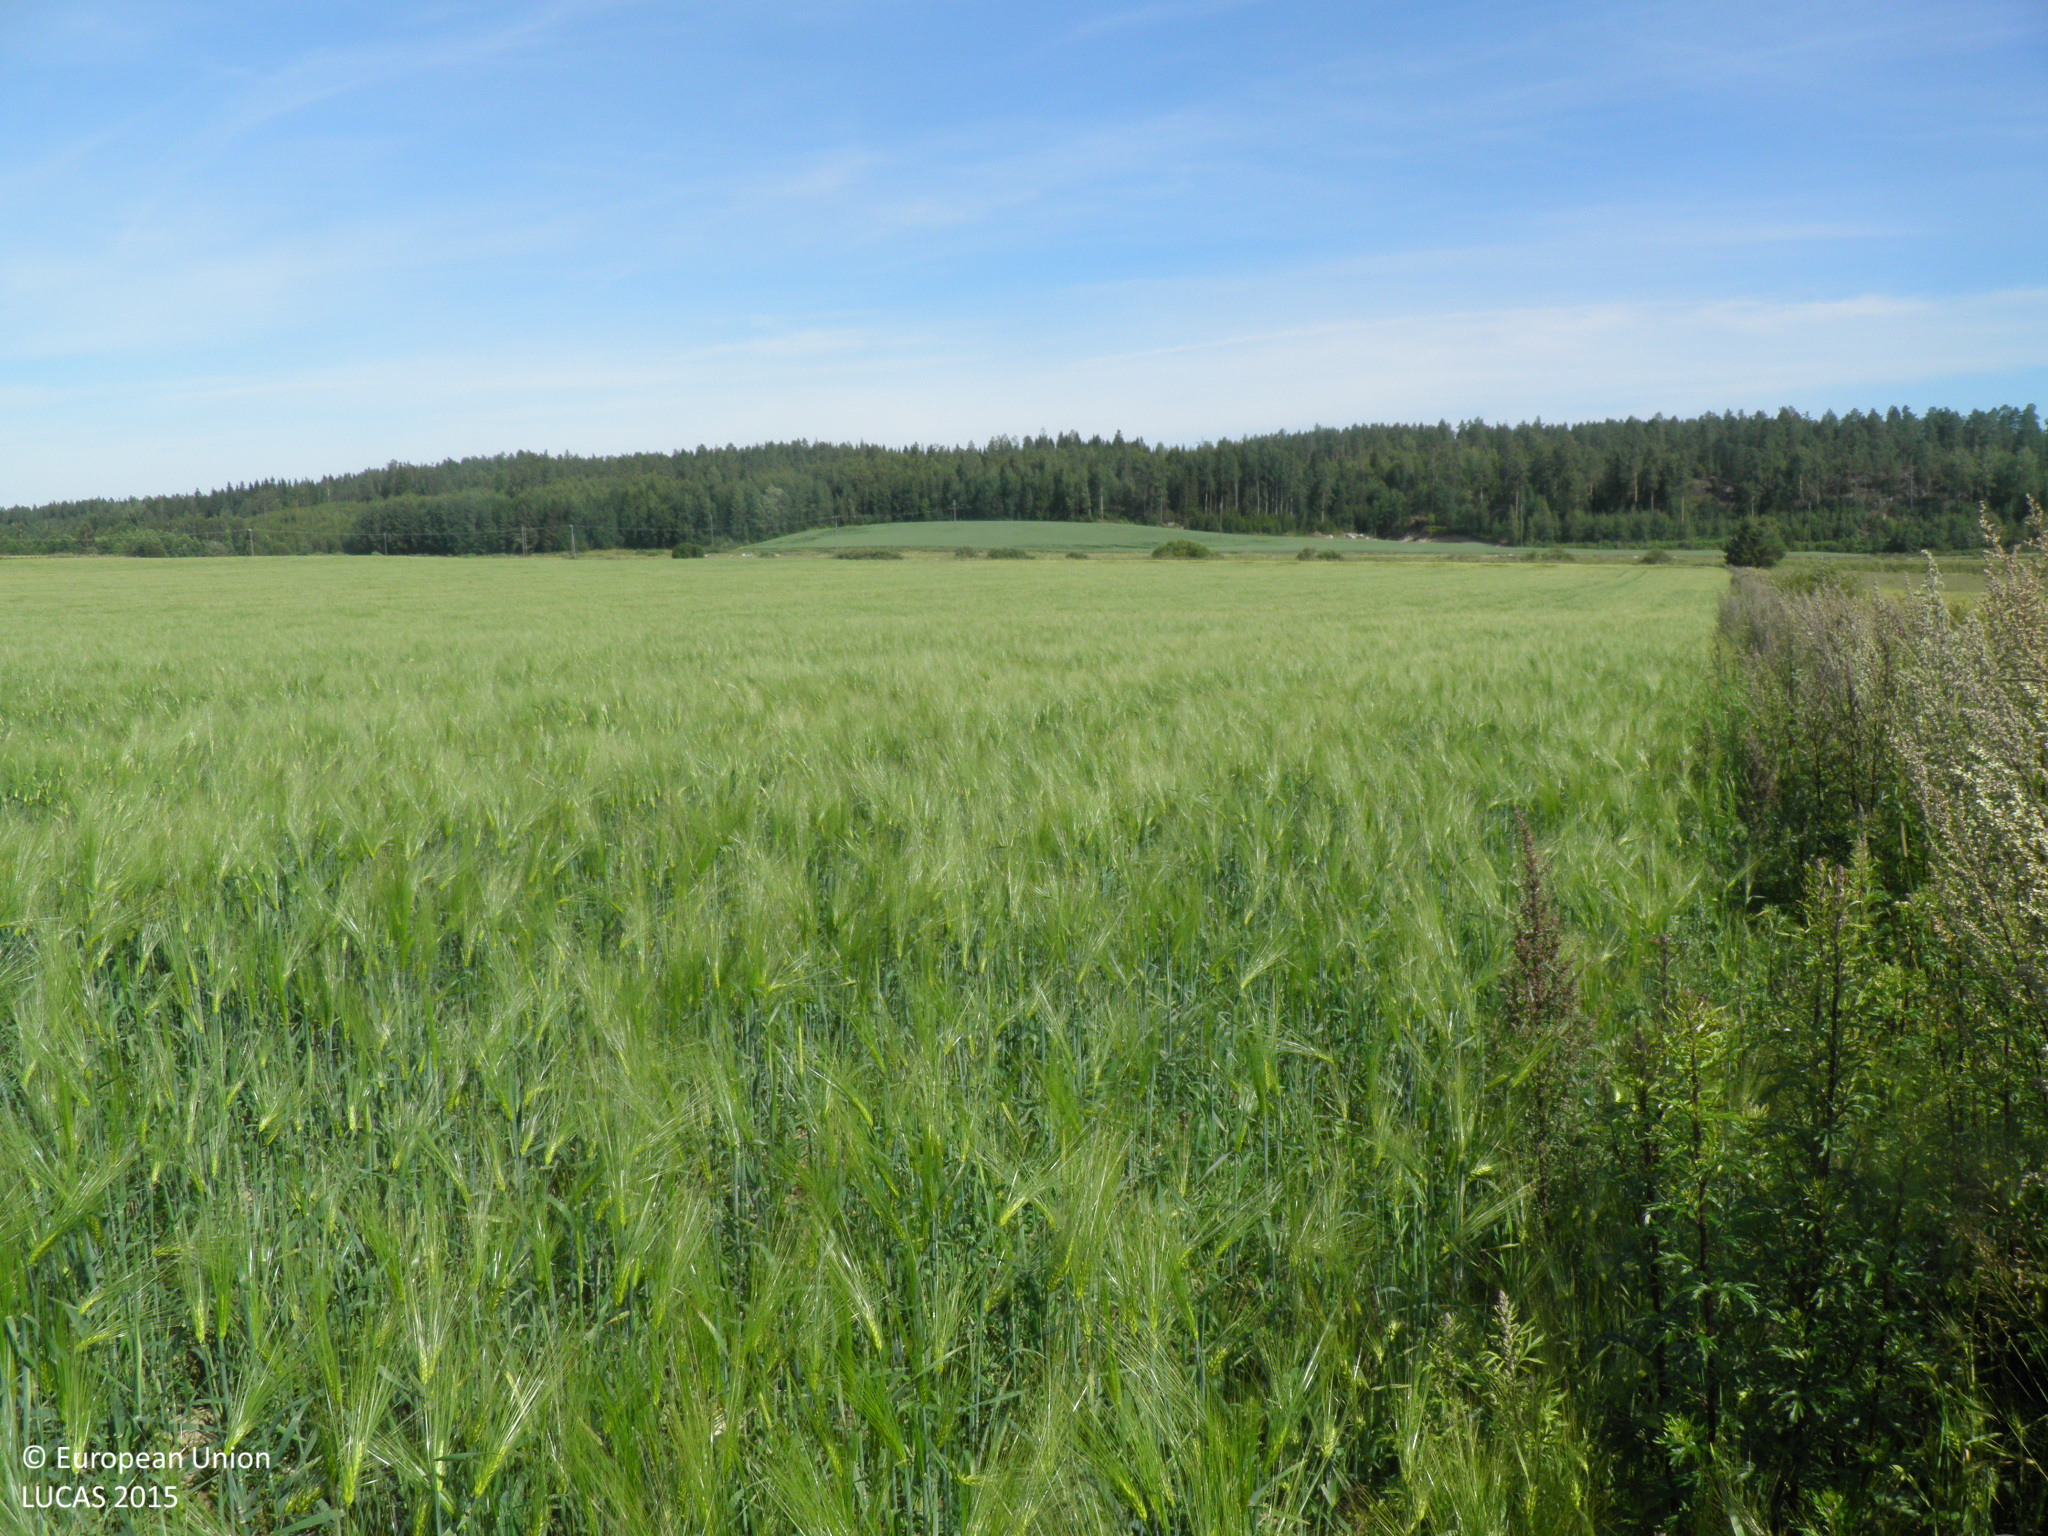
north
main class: Cropland
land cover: Barley
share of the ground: > 75 %
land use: Agriculture (excluding fallow land and kitchen gardens)
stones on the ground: < 10 %
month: August
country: FI
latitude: 61.0041
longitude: 22.7759
